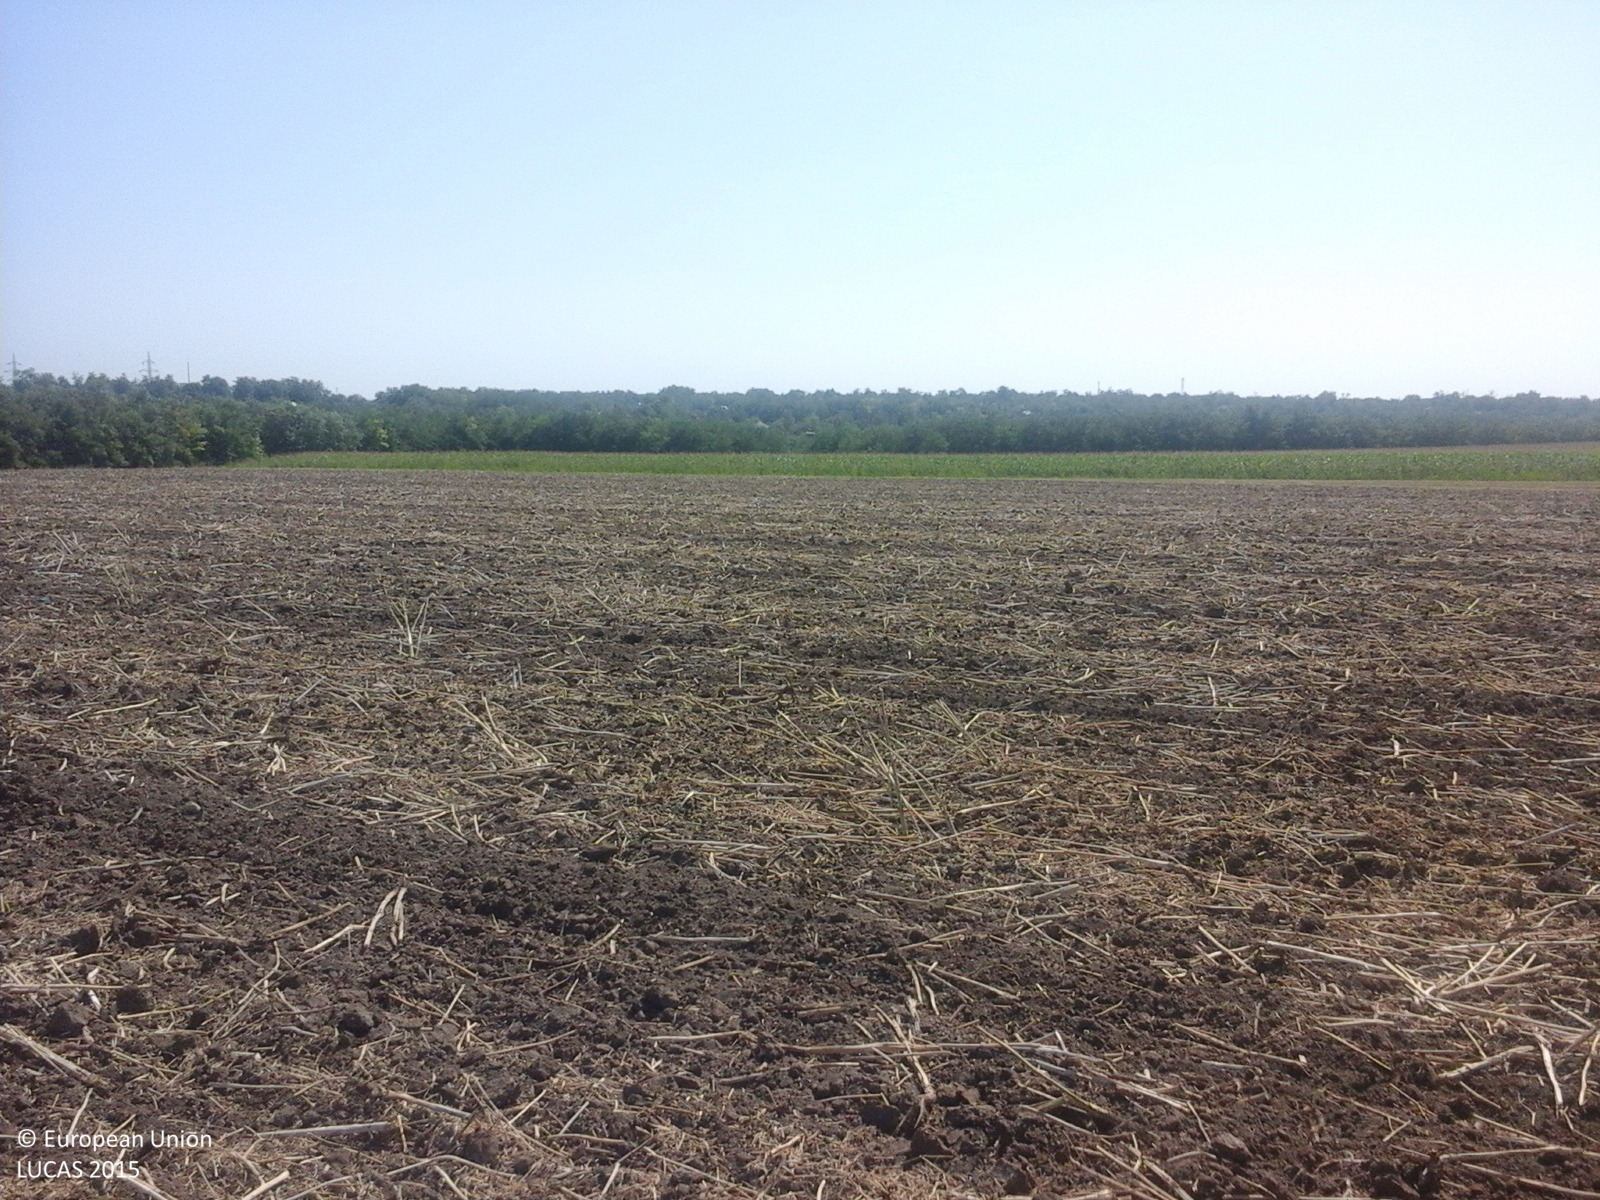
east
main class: Cropland
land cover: Rape and turnip rape
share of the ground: < 10 %
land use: Agriculture (excluding fallow land and kitchen gardens)
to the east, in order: Rape and turnip rape; Lucerne; Maize; Arable land (only in case pi)
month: July
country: RO
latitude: 44.3397
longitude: 27.0743
